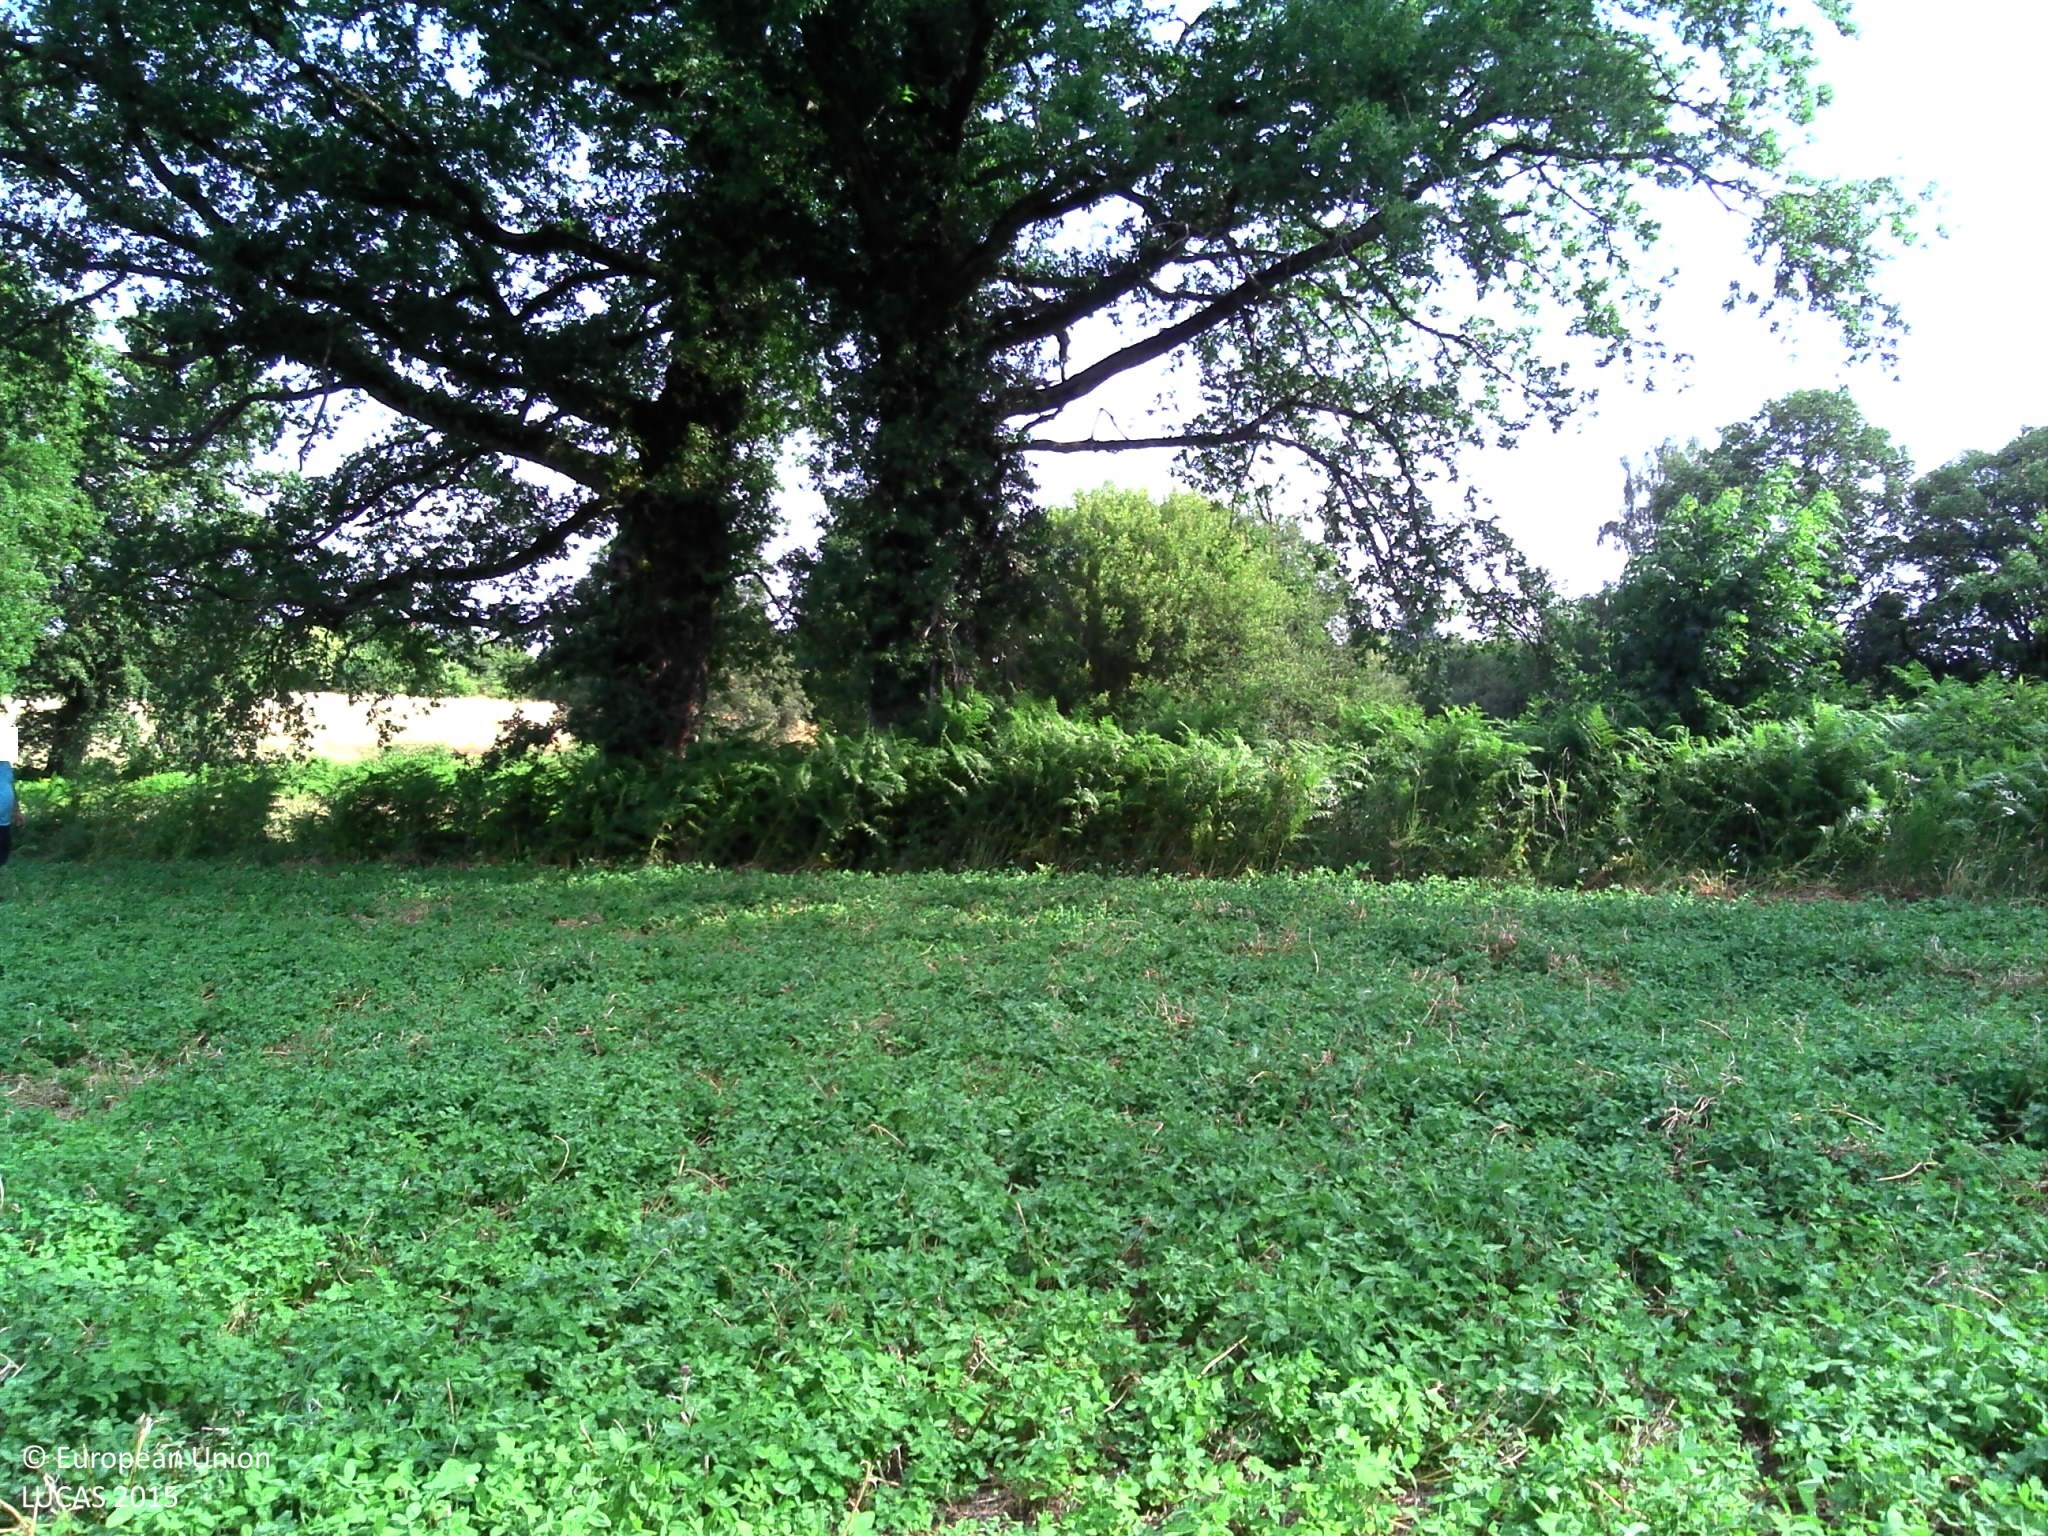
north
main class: Cropland
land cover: Clovers
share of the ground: > 75 %
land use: Agriculture (excluding fallow land and kitchen gardens)
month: July
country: FR
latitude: 46.0940
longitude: 1.3892
